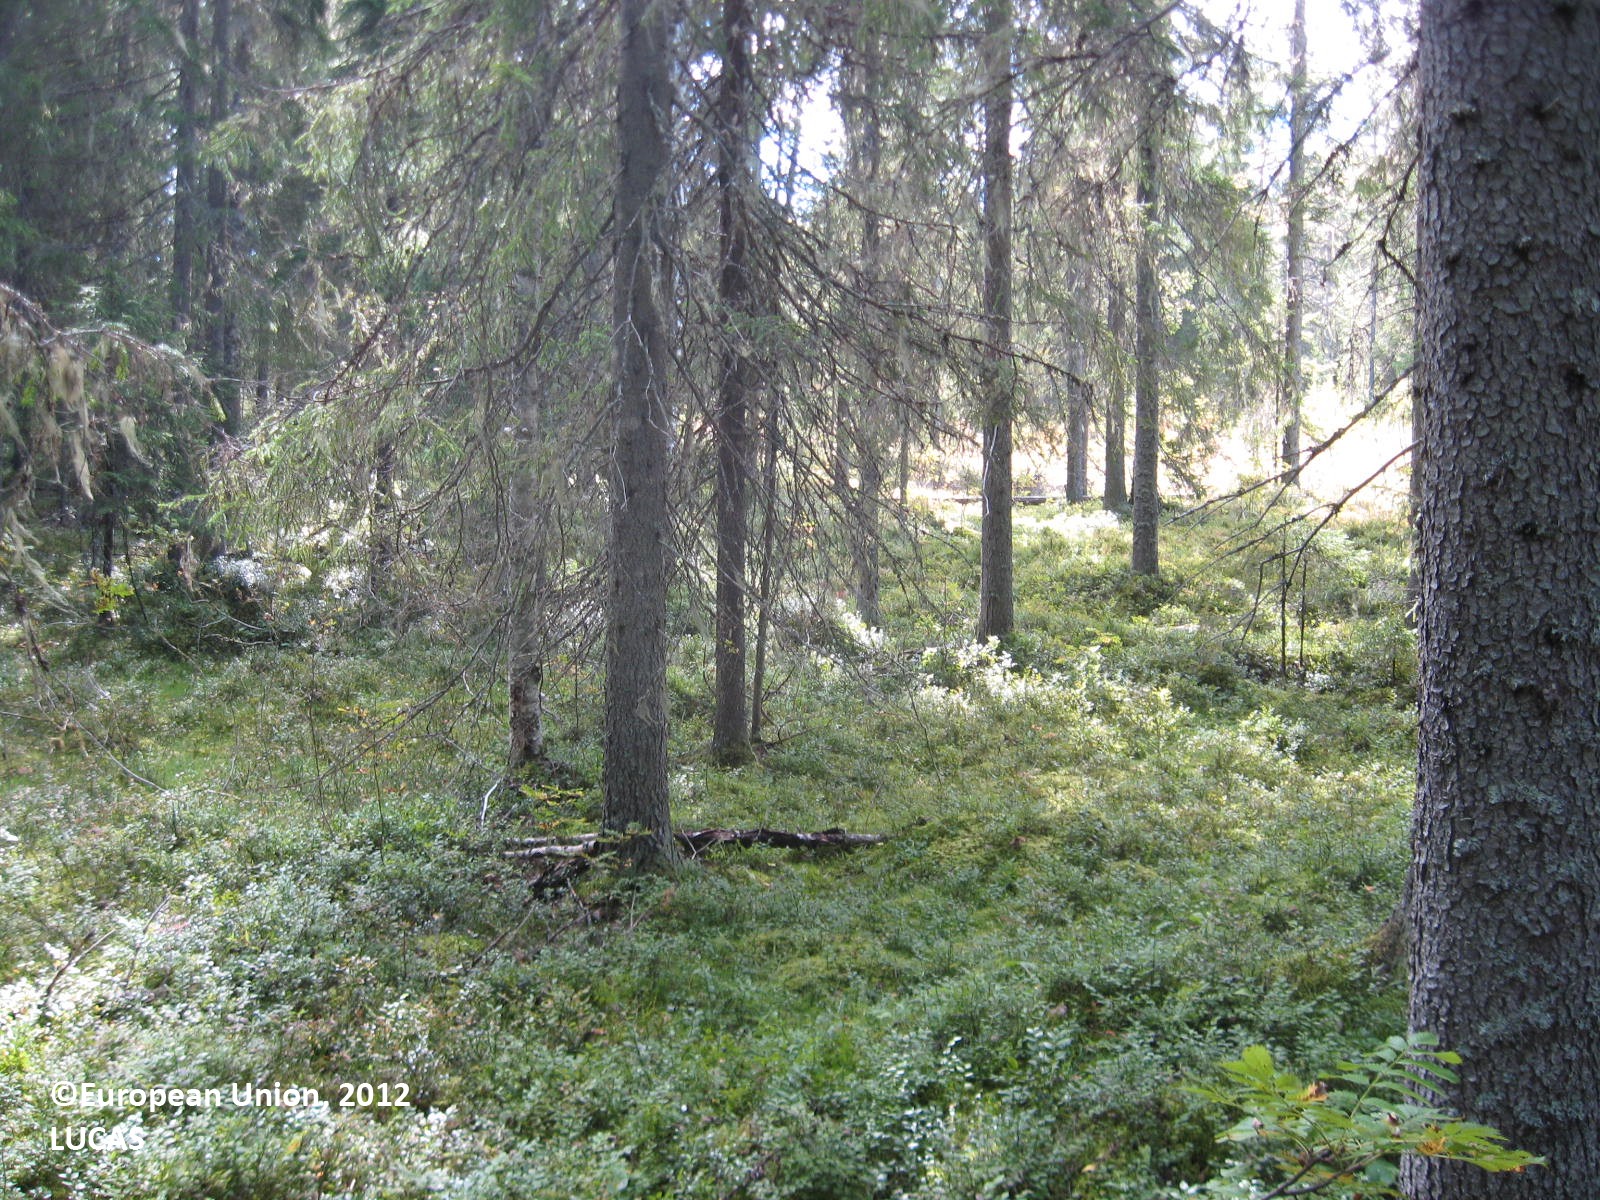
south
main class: Woodland
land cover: Spruce dominated coniferous woodland
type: boreal forest
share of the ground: > 75 %
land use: Forestry
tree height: > 5 m
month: August
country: FI
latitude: 63.8001
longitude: 29.8270
